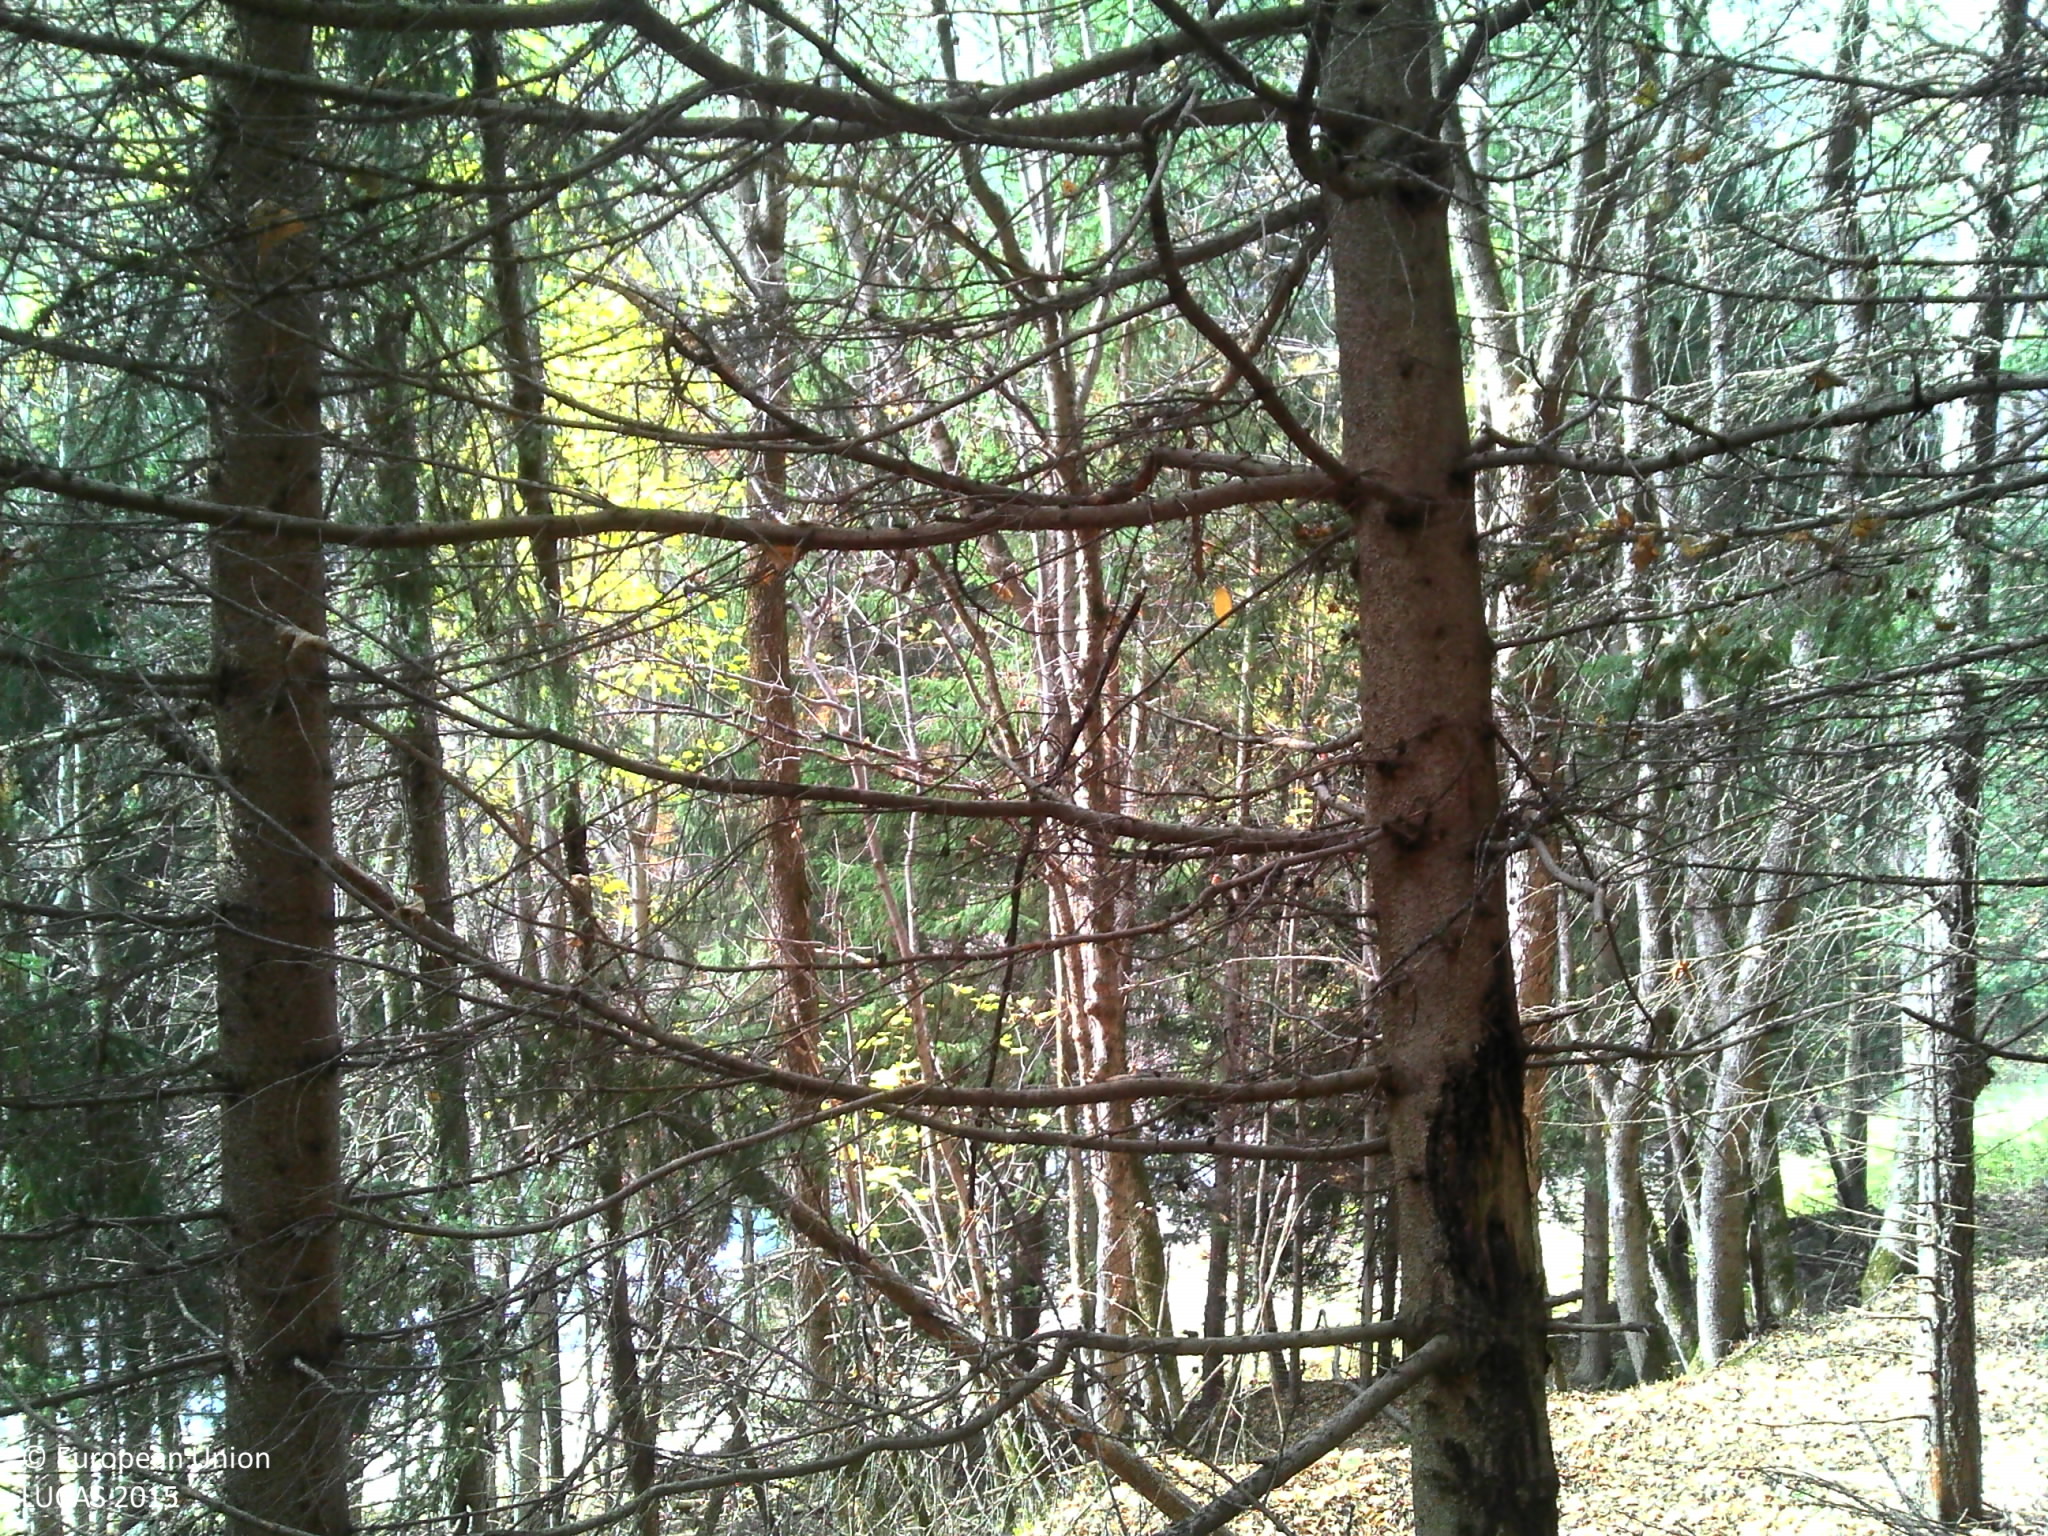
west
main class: Woodland
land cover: Other mixed woodland
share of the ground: > 75 %
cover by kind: coniferous forest trees 50 %, broadleaved forest trees 30 %, unconsolidated bare surface 15 %, shrubs 5 %
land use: Forestry
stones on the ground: < 10 %
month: October
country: FR
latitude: 45.1735
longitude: 6.4297
